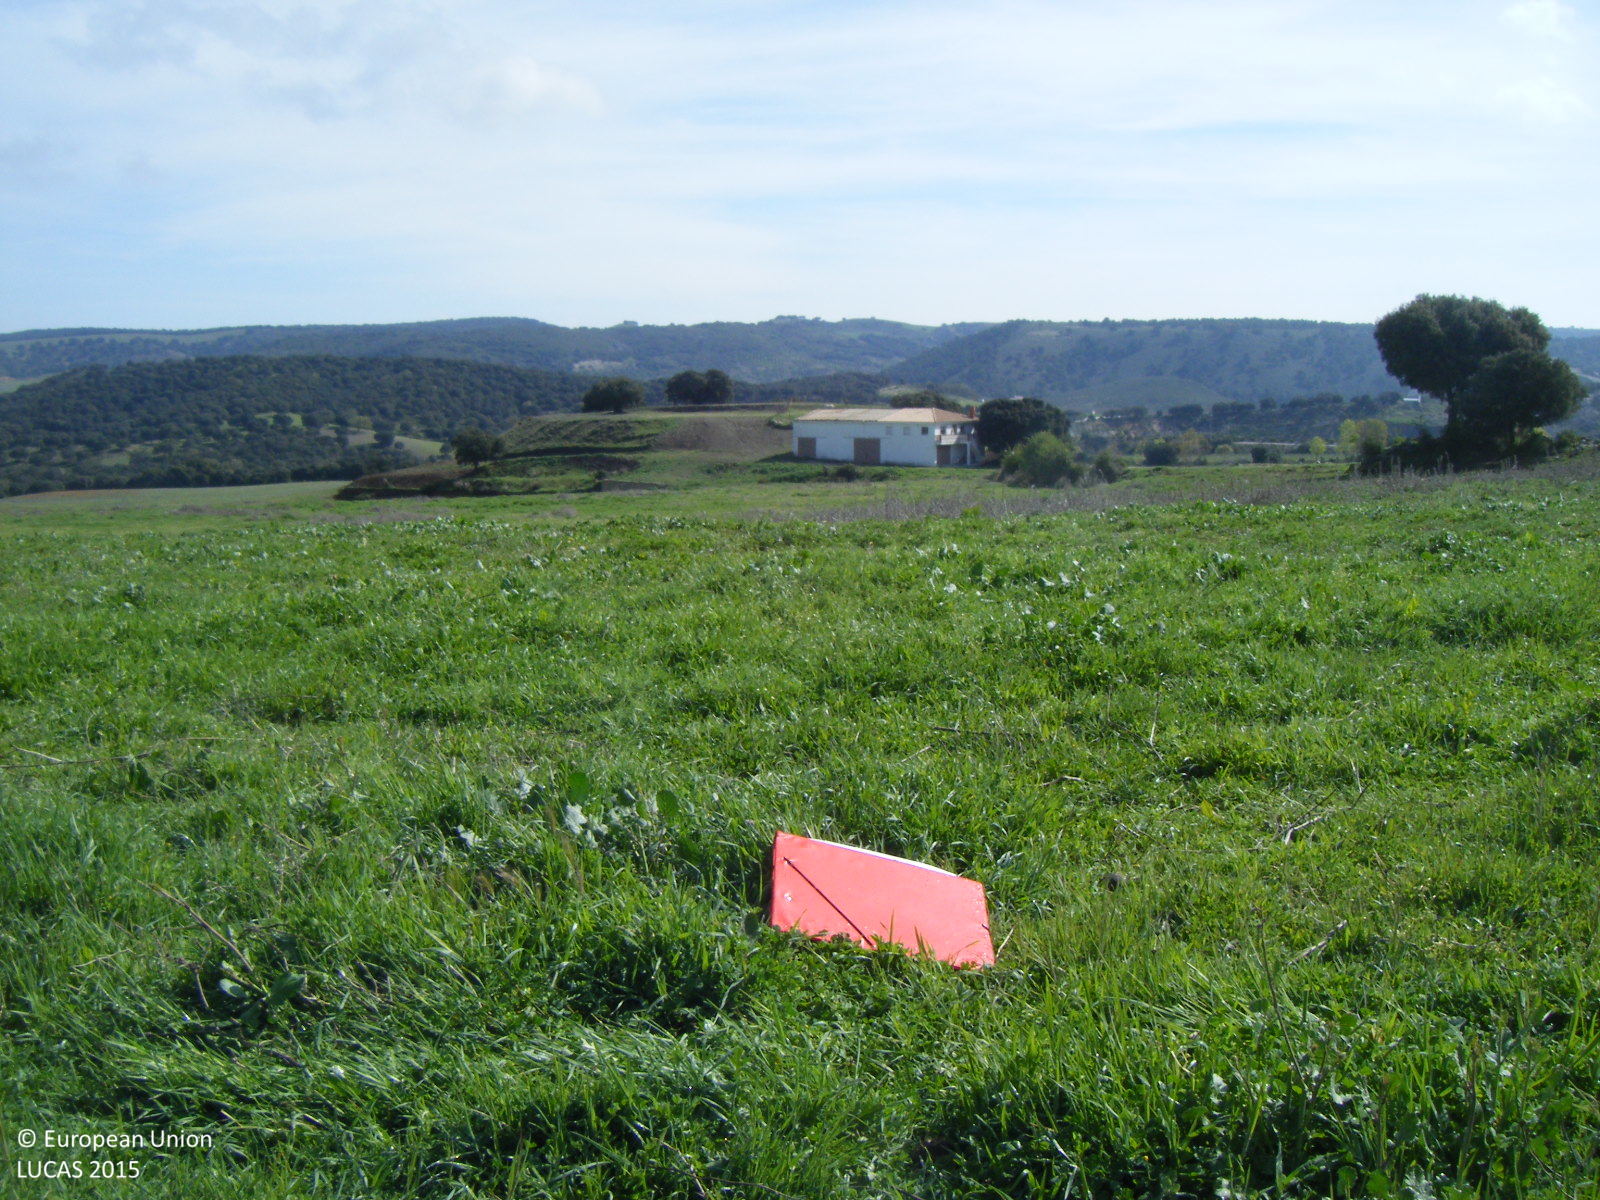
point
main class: Grassland
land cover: Spontaneously vegetated surfaces
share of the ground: > 75 %
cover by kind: herbaceous plants 100 %
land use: Agriculture (excluding fallow land and kitchen gardens)
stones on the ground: < 10 %
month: April
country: ES
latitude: 36.9398
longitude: -4.0360
